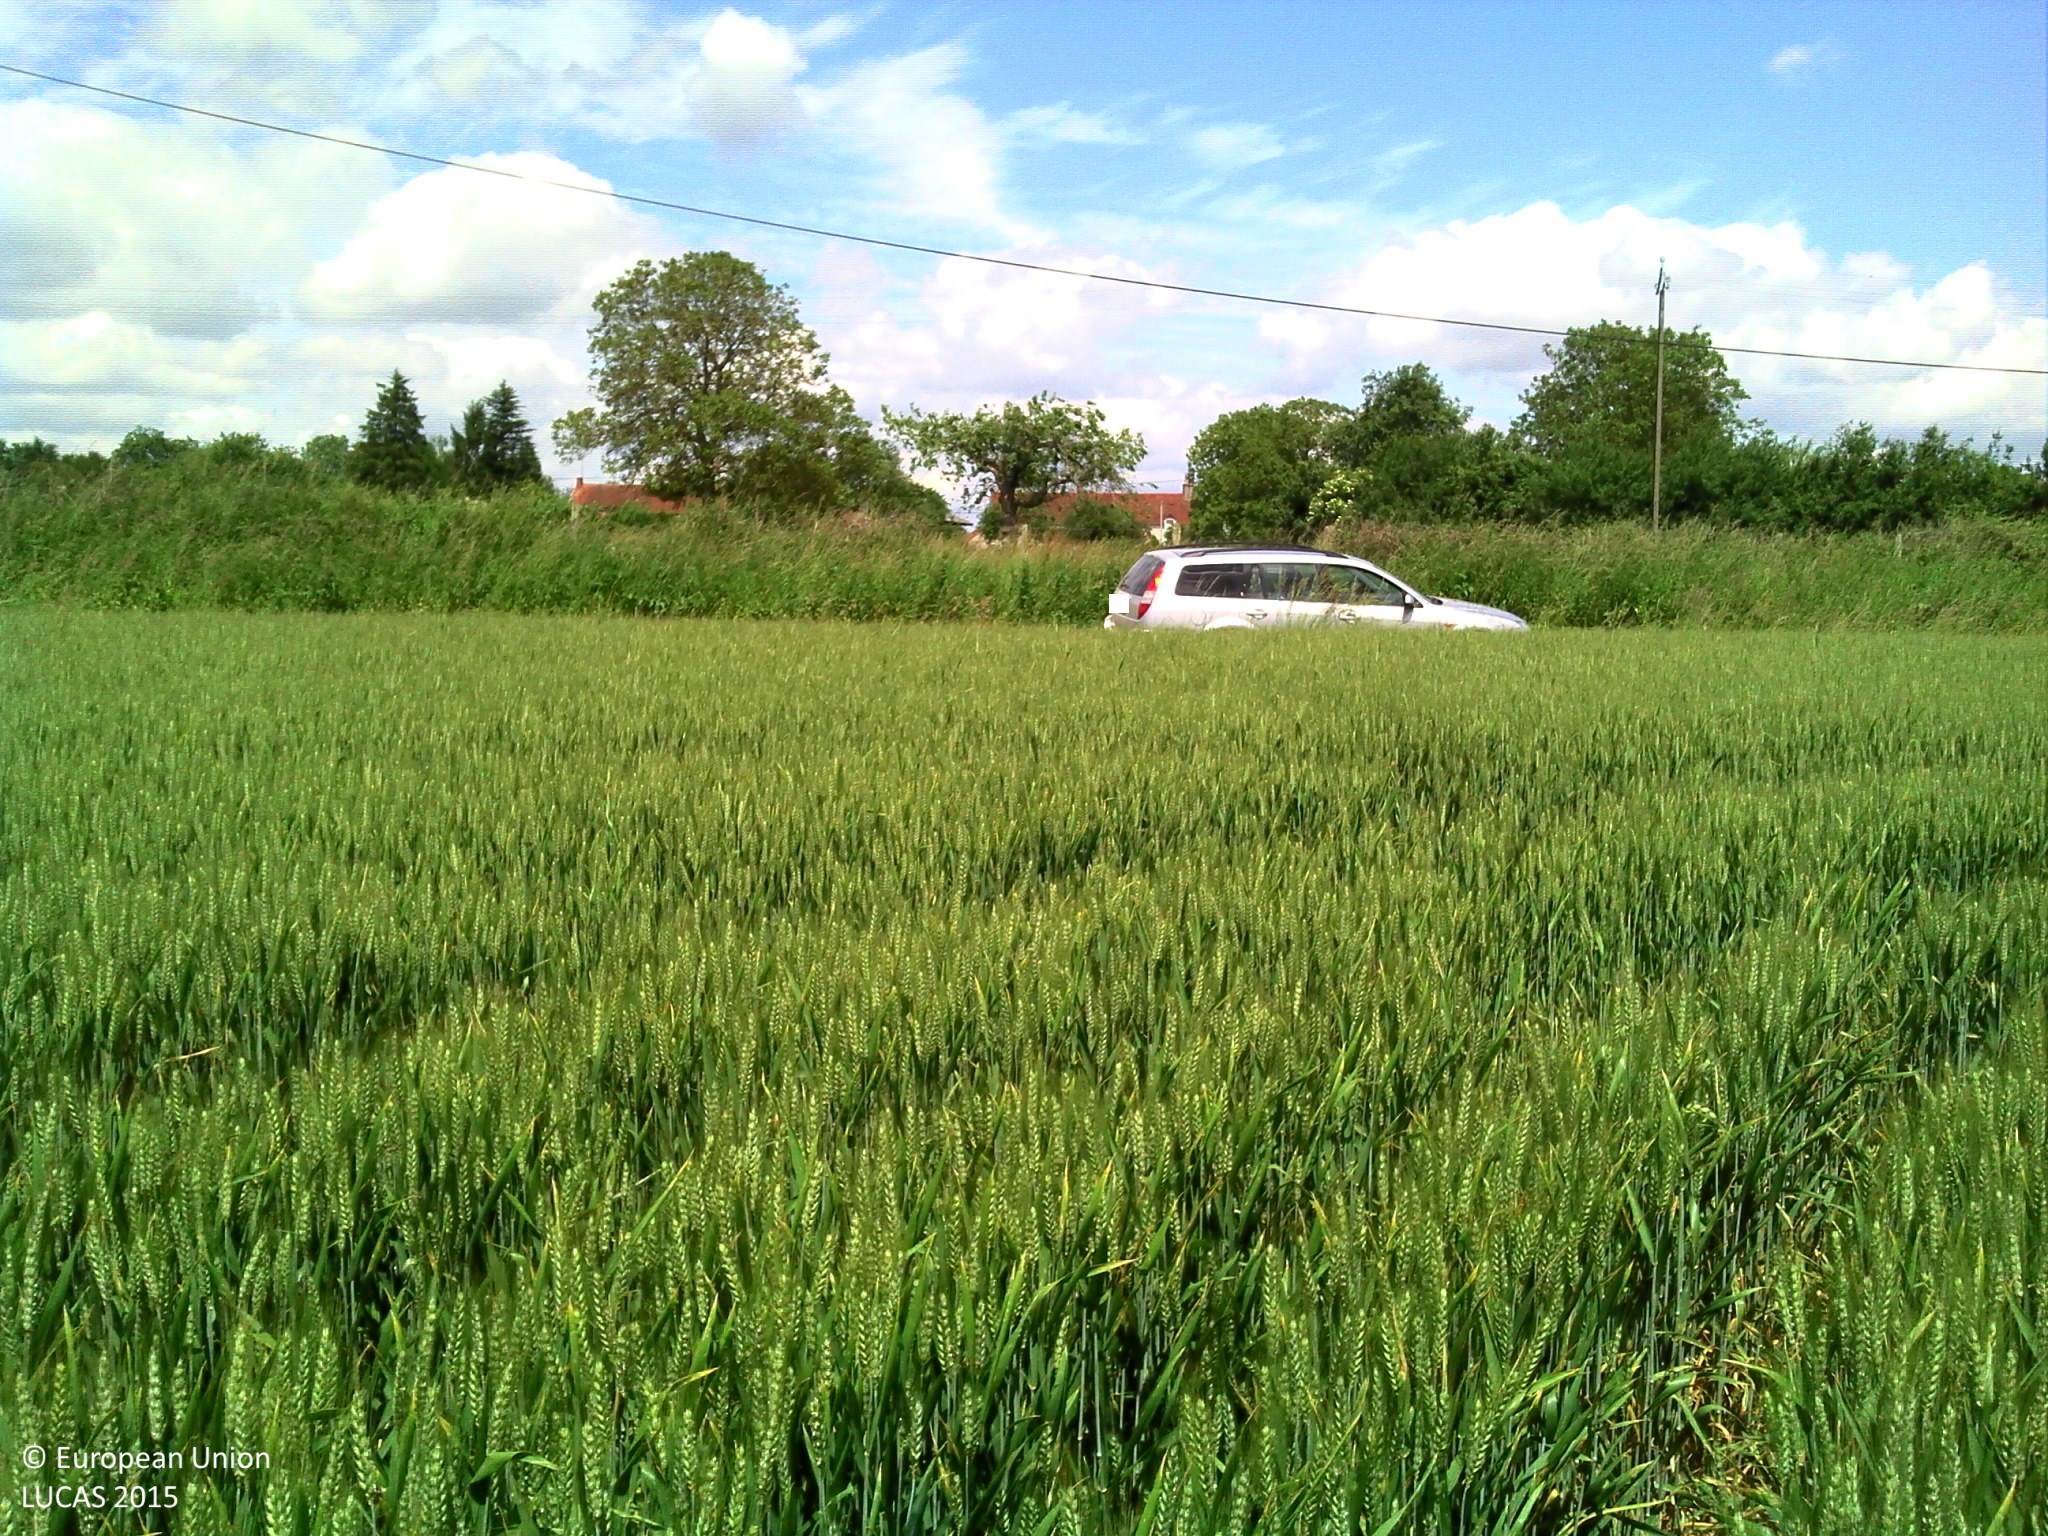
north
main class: Cropland
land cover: Common wheat
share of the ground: > 75 %
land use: Agriculture (excluding fallow land and kitchen gardens)
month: May
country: FR
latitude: 47.2017
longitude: 2.9324
